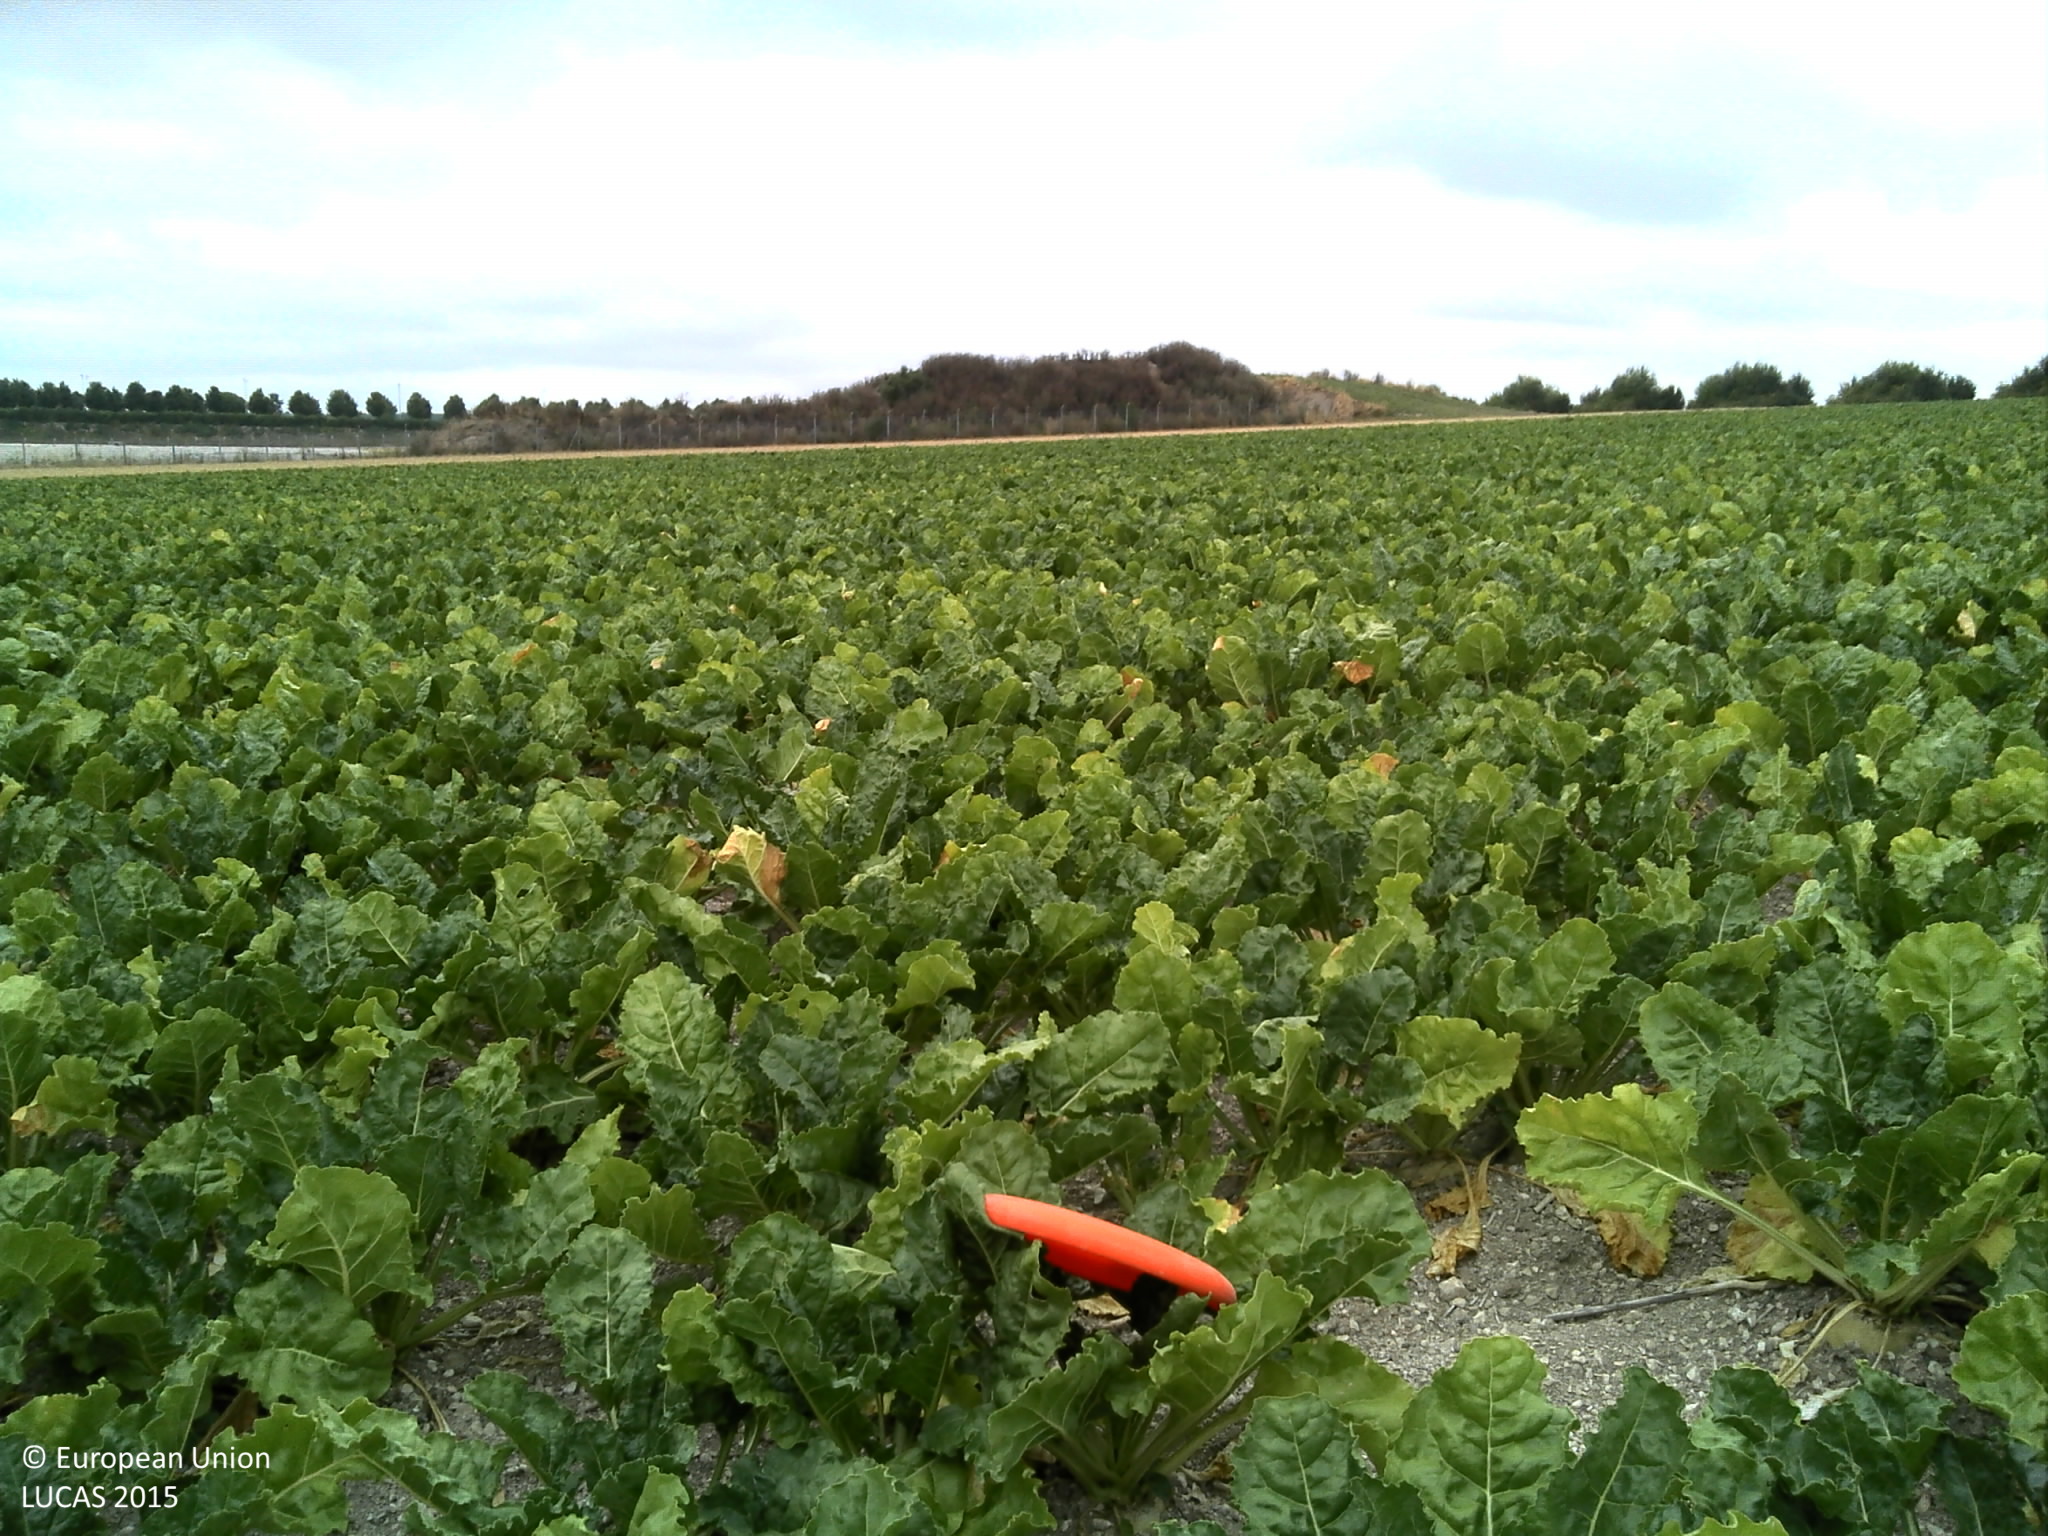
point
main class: Cropland
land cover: Sugar beet
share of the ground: 50 - 75 %
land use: Agriculture (excluding fallow land and kitchen gardens)
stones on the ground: < 10 %
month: August
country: FR
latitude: 48.7764
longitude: 4.2400
